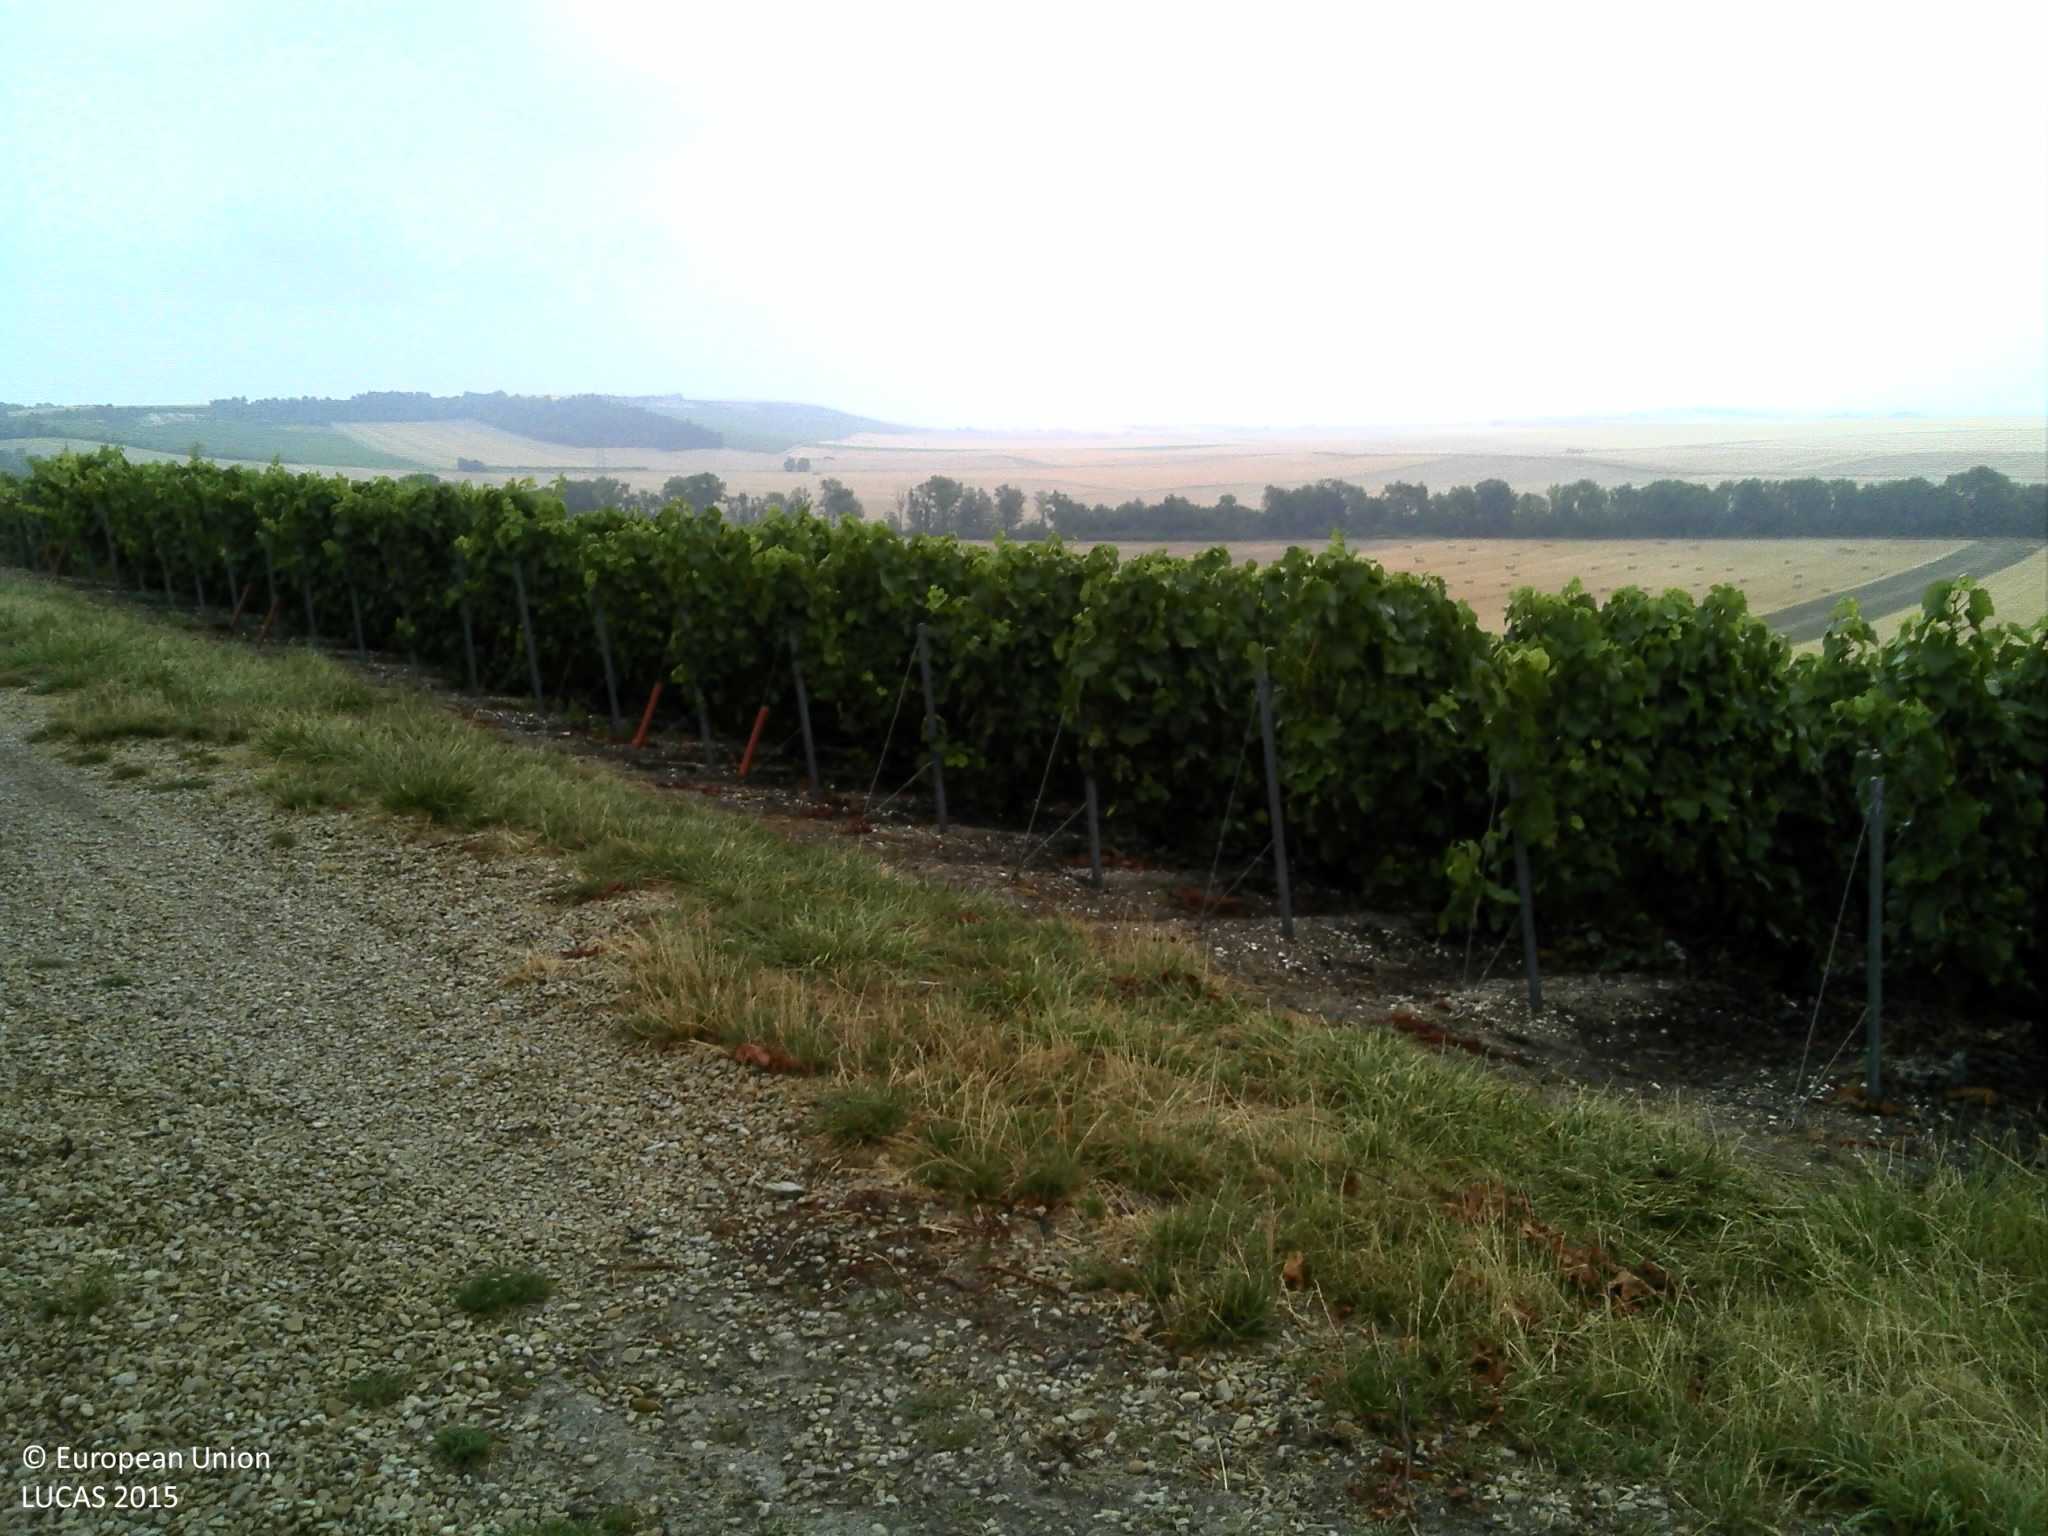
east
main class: Cropland
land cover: Vineyards
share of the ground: 25 - 50 %
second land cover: Other bare soil
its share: > 75 %
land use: Agriculture (excluding fallow land and kitchen gardens)
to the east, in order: Lines of trees; Tracks; Grass margins; Vineyards; Grassland without tree/shrub cover; Vineyards; Grassland without tree/shrub cover; Grass margins; Tracks; Grass margins; Rape and turnip rape
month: August
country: FR
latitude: 48.8160
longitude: 4.6724
